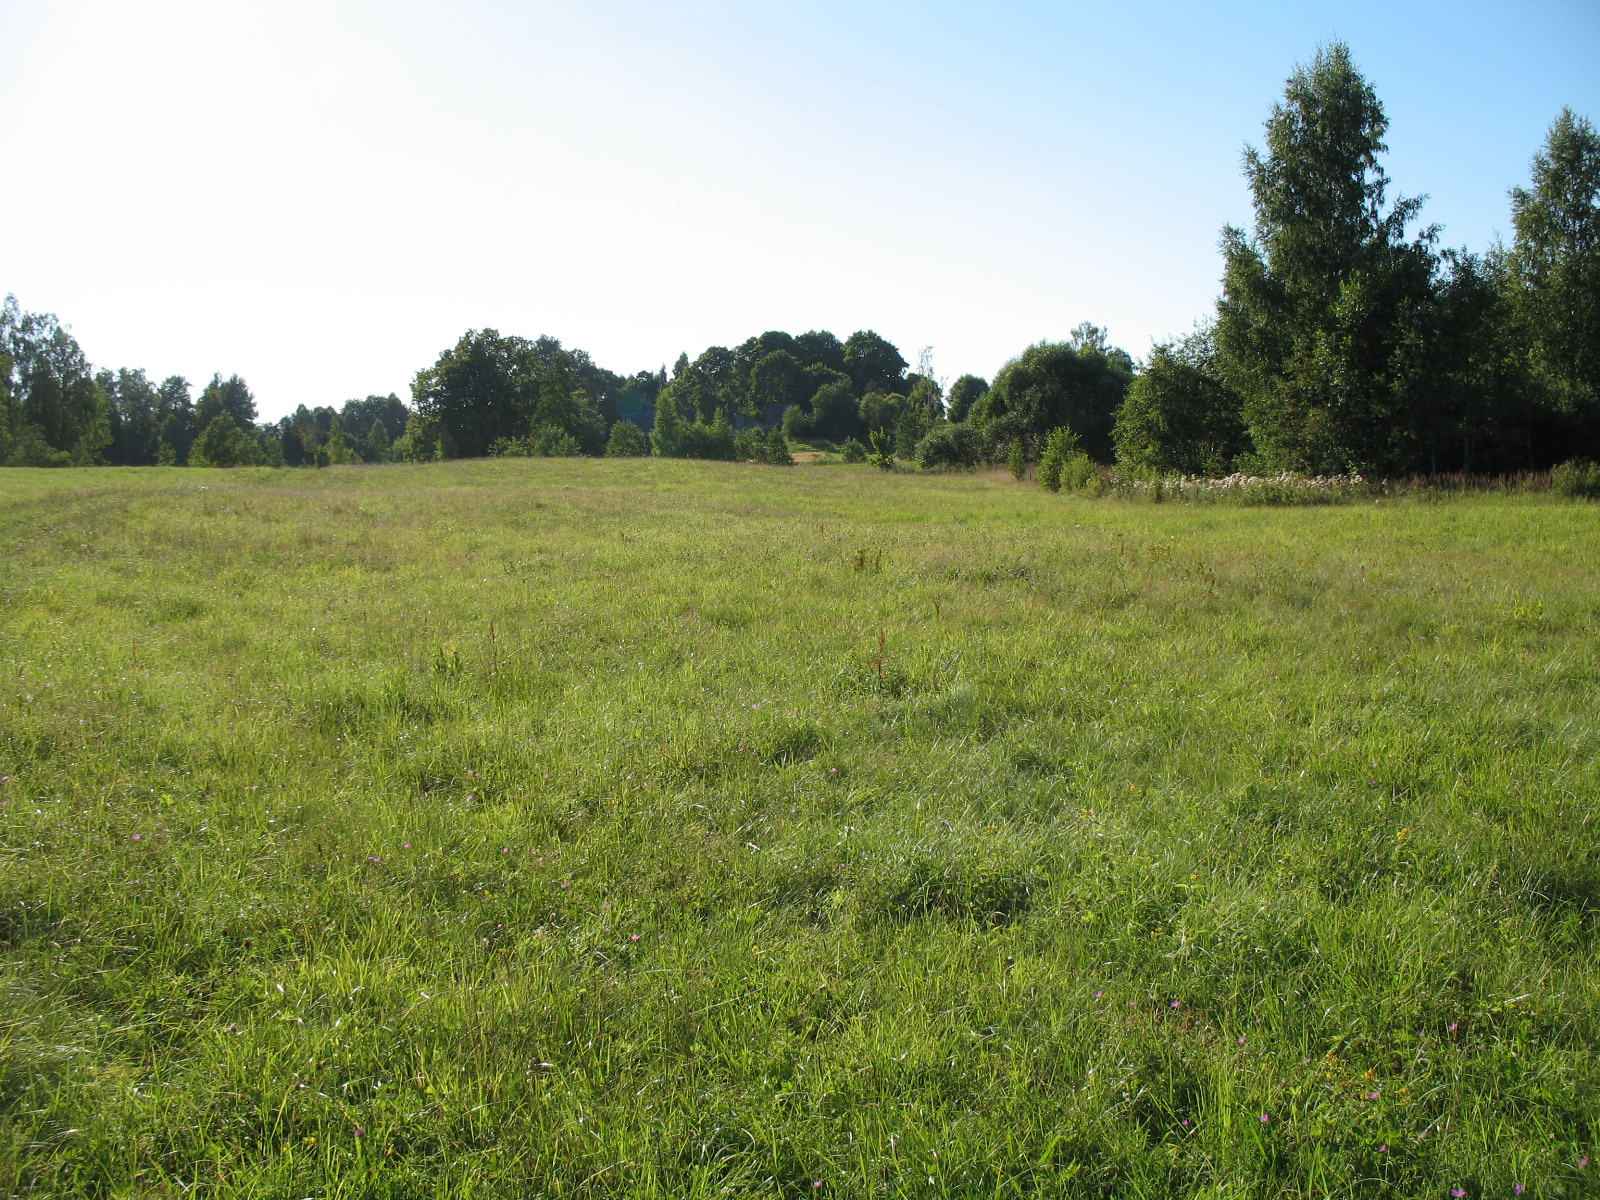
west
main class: Grassland
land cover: Grassland without tree/shrub cover
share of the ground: > 75 %
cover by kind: herbaceous plants 100 %
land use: Agriculture (excluding fallow land and kitchen gardens)
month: August
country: LV
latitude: 56.4915
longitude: 25.6012
